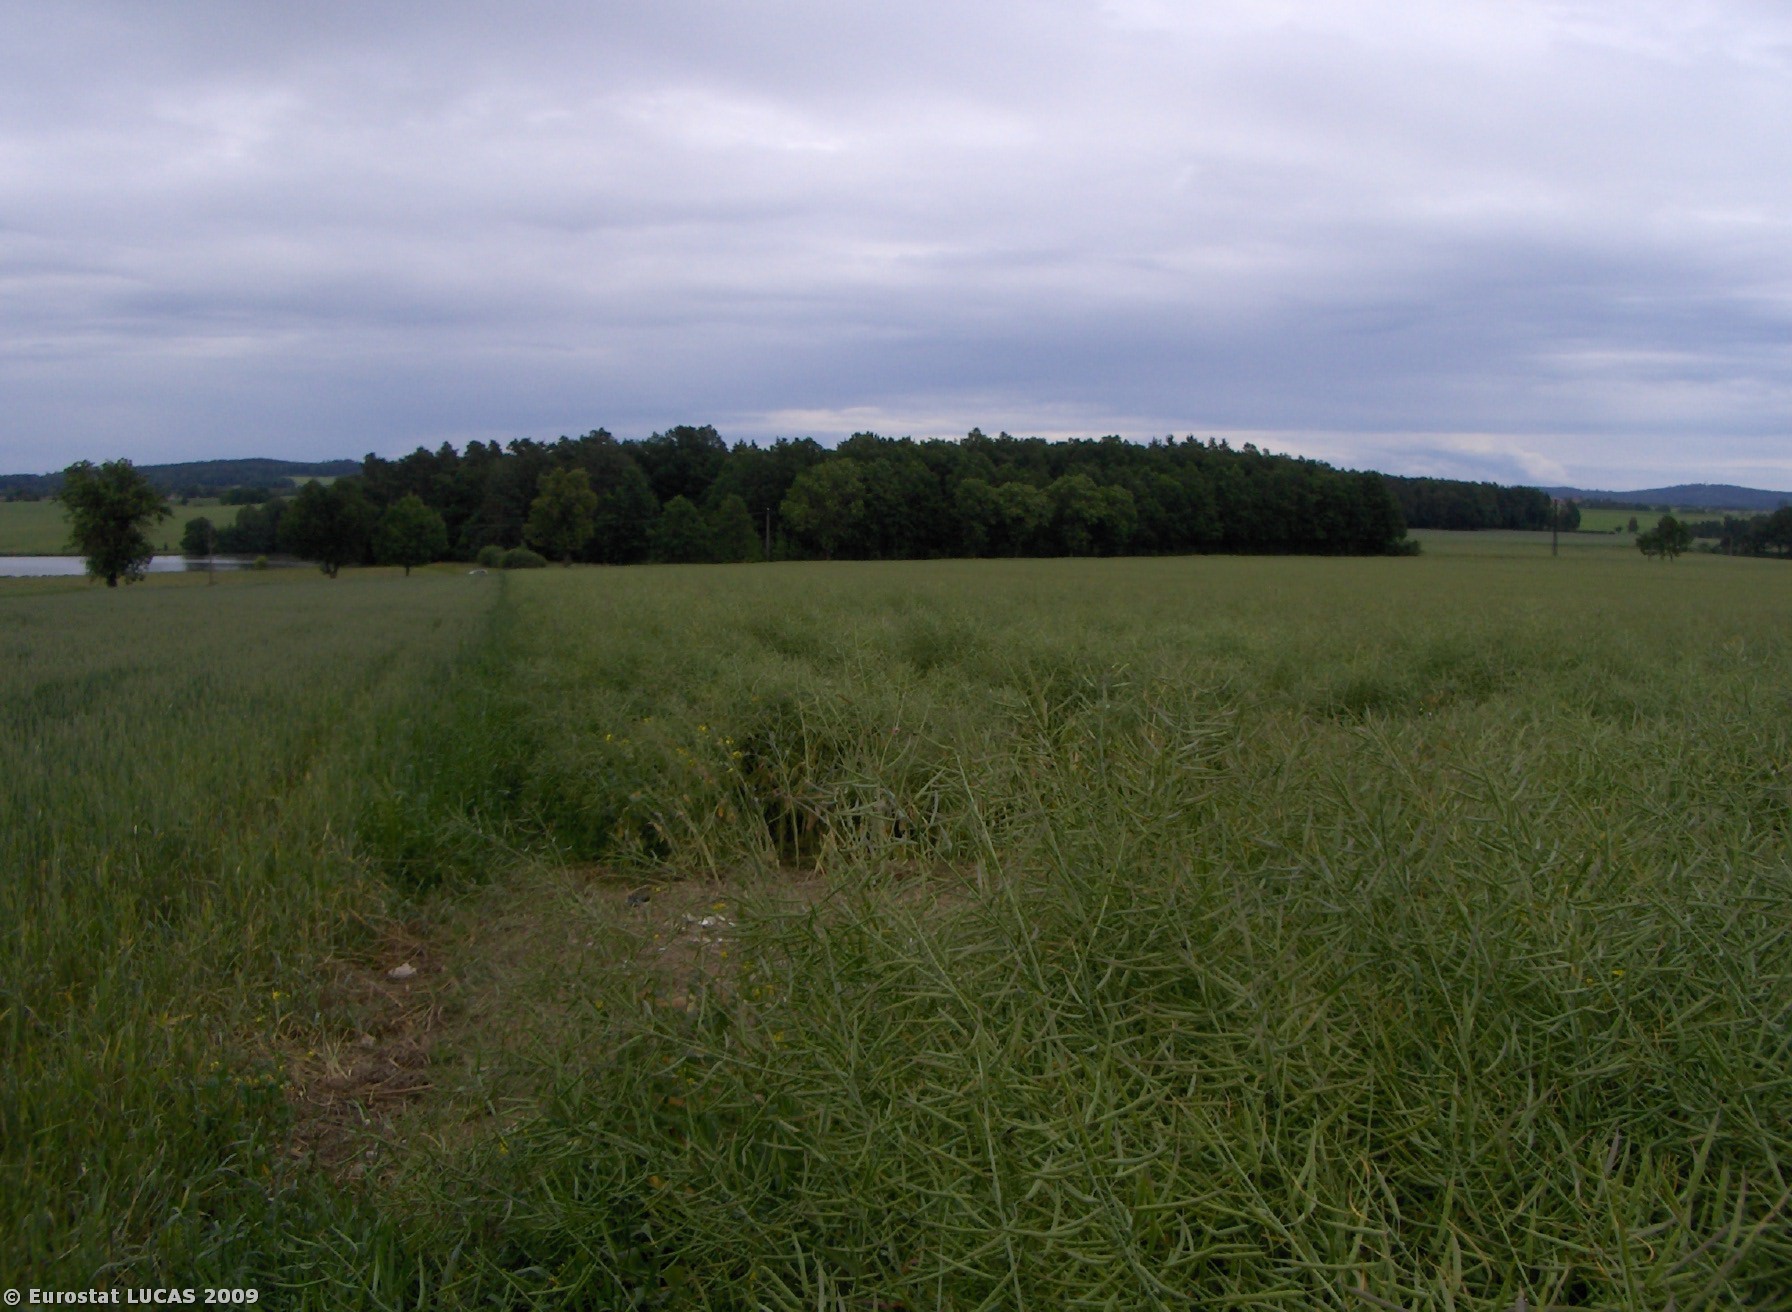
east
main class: Cropland
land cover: Rape and turnip rape
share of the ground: > 75 %
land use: Agriculture (excluding fallow land and kitchen gardens)
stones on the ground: < 10 %
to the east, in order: Rape and turnip rape
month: June
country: CZ
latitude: 49.1299
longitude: 14.3179
